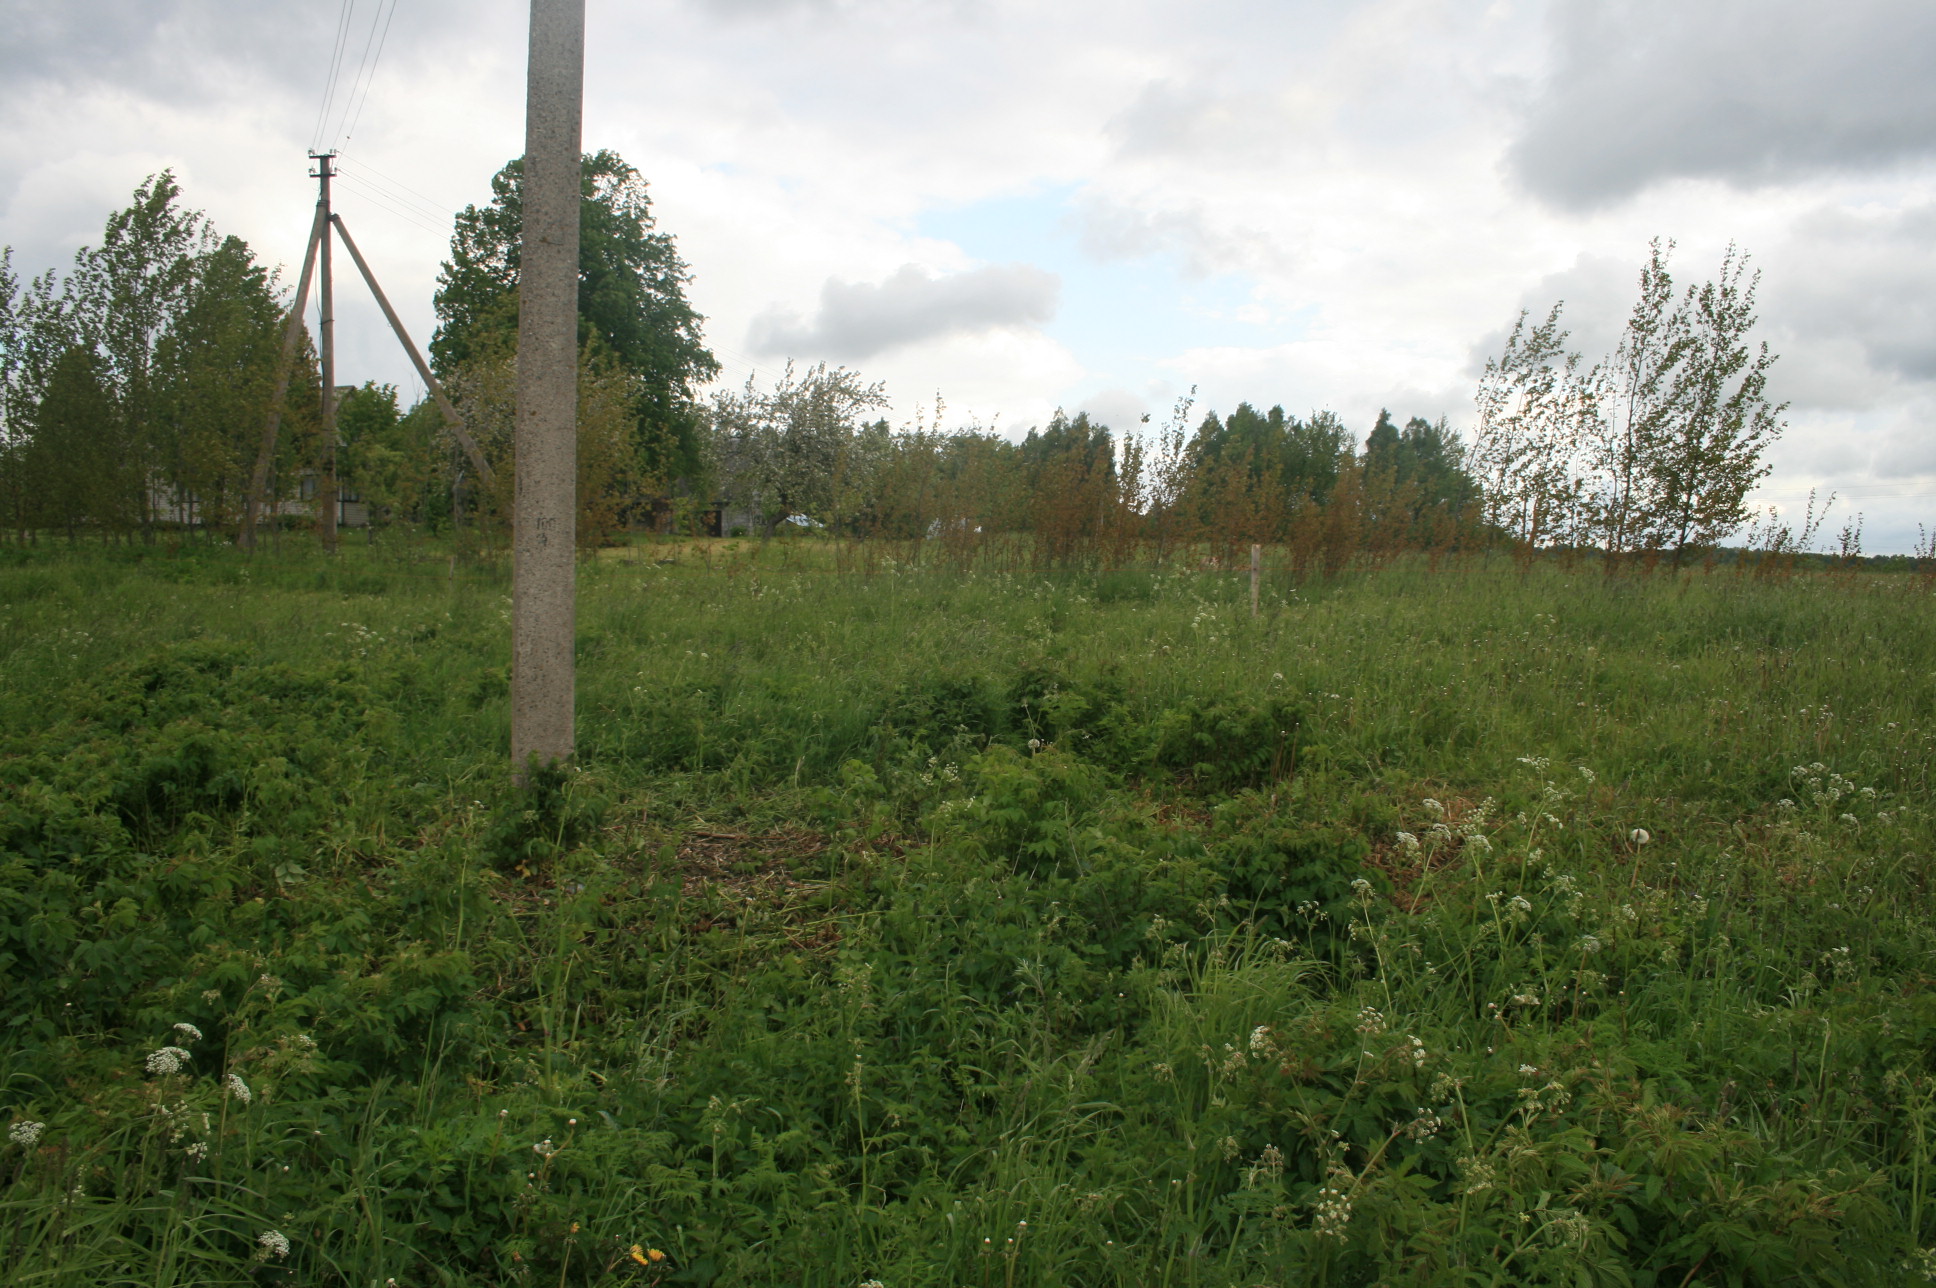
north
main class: Grassland
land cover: Grassland without tree/shrub cover
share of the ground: > 75 %
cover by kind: herbaceous plants 100 %
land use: Agriculture (excluding fallow land and kitchen gardens)
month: May
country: LT
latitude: 55.9250
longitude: 21.8765
